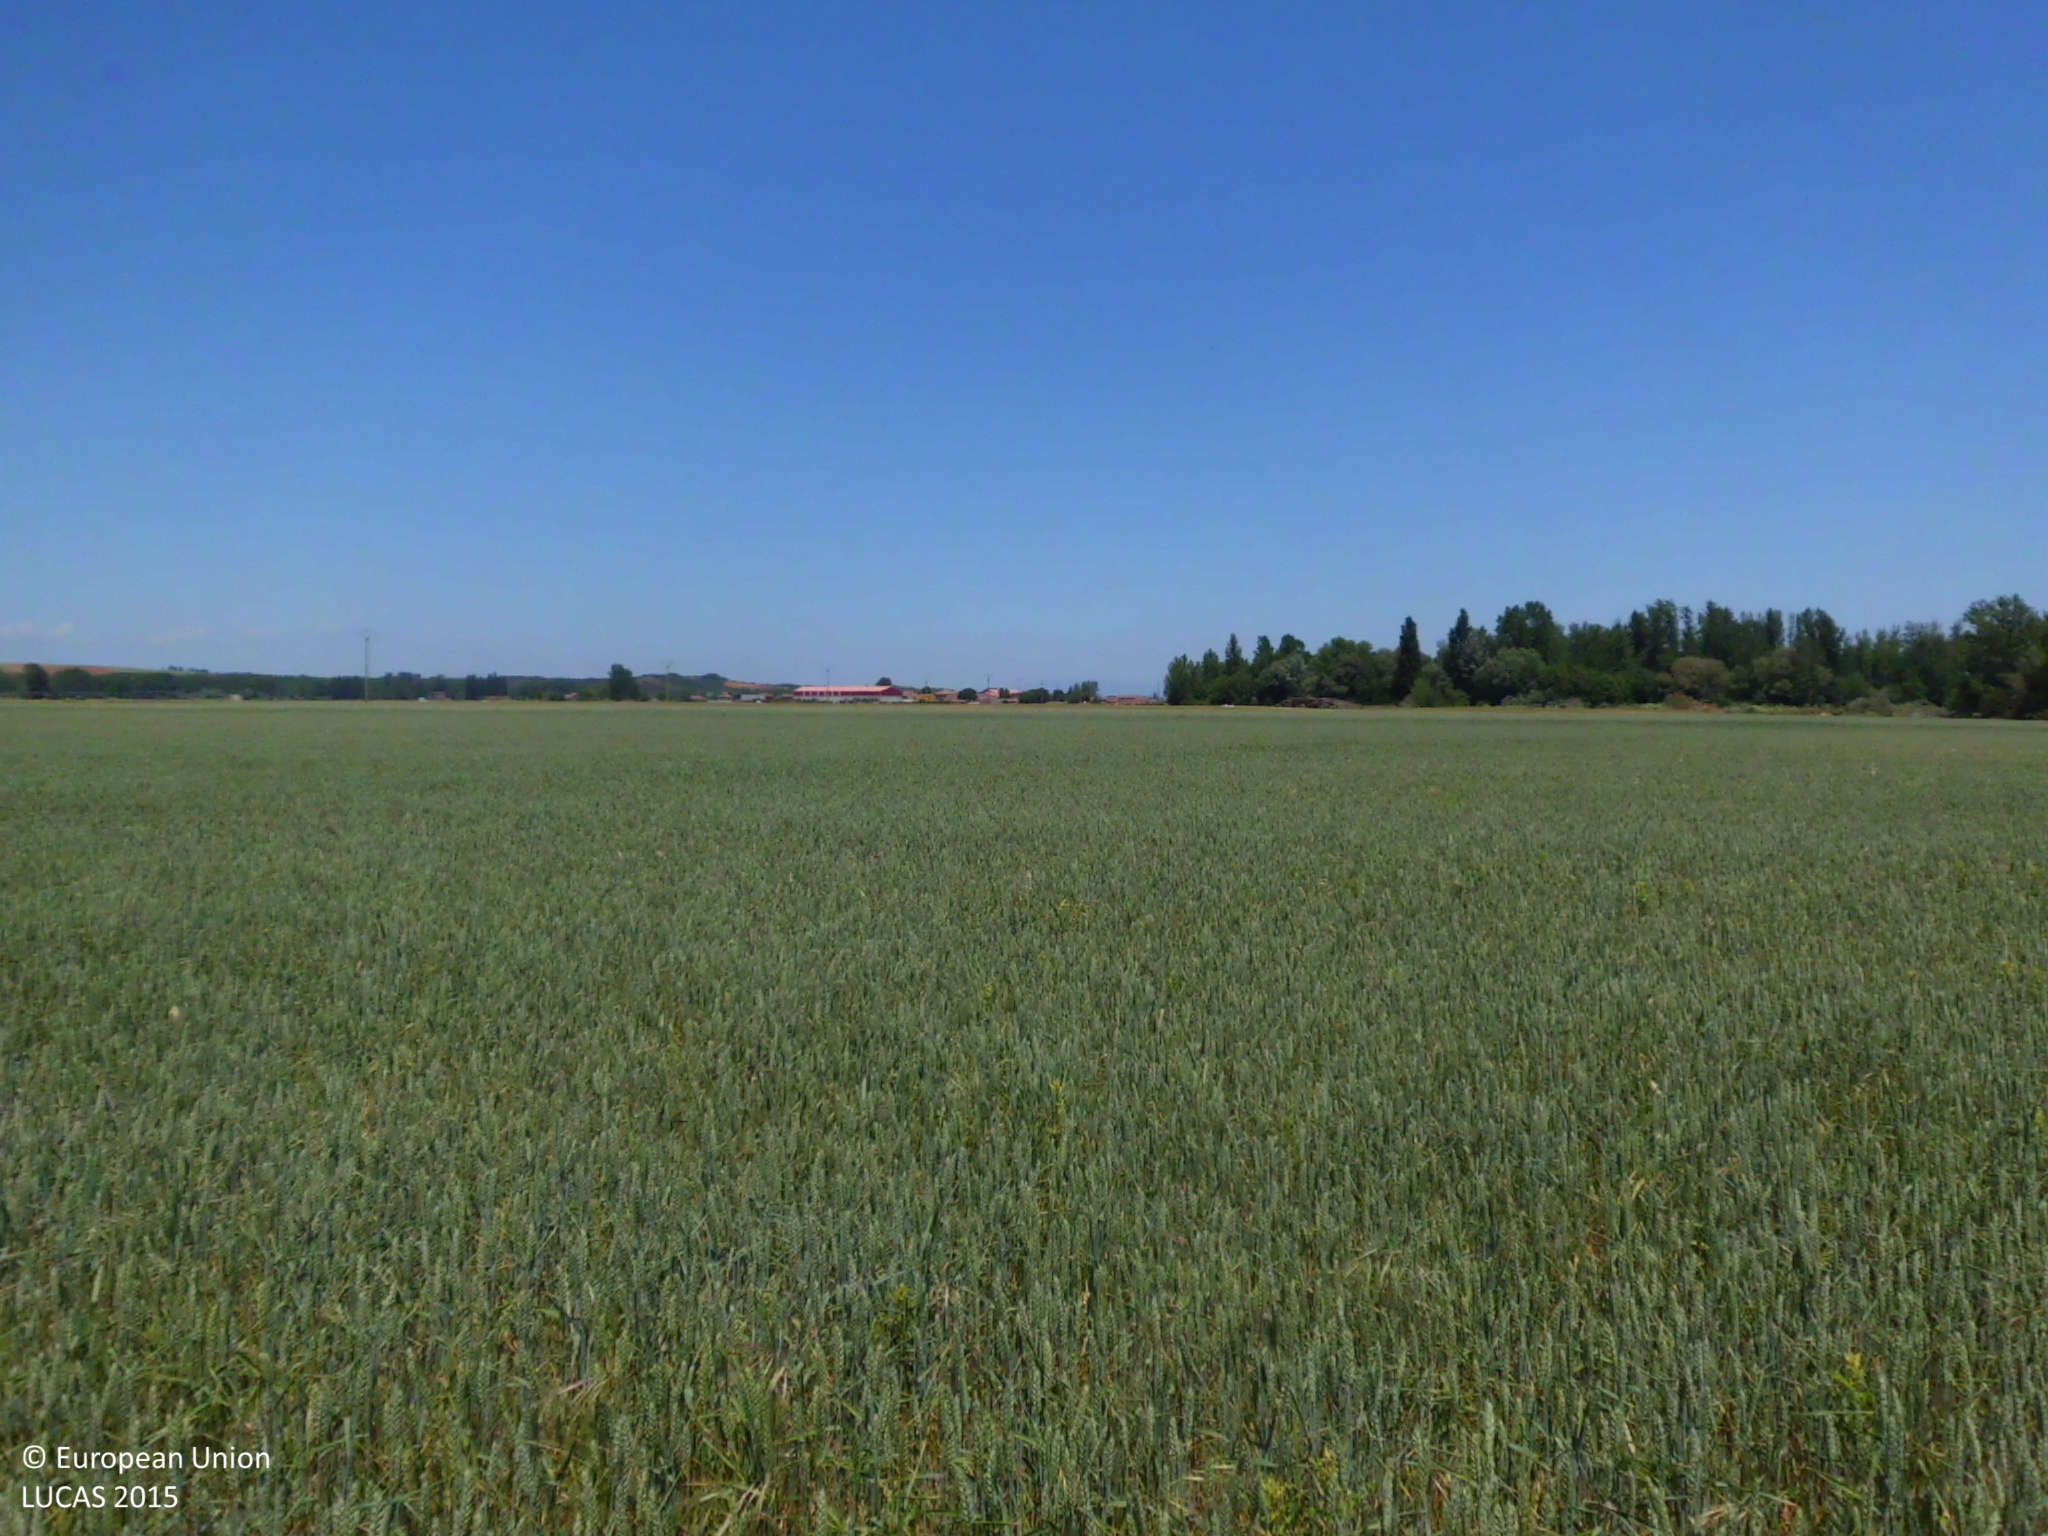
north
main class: Cropland
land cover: Common wheat
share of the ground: > 75 %
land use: Agriculture (excluding fallow land and kitchen gardens)
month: June
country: ES
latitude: 42.4273
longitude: -4.2546
